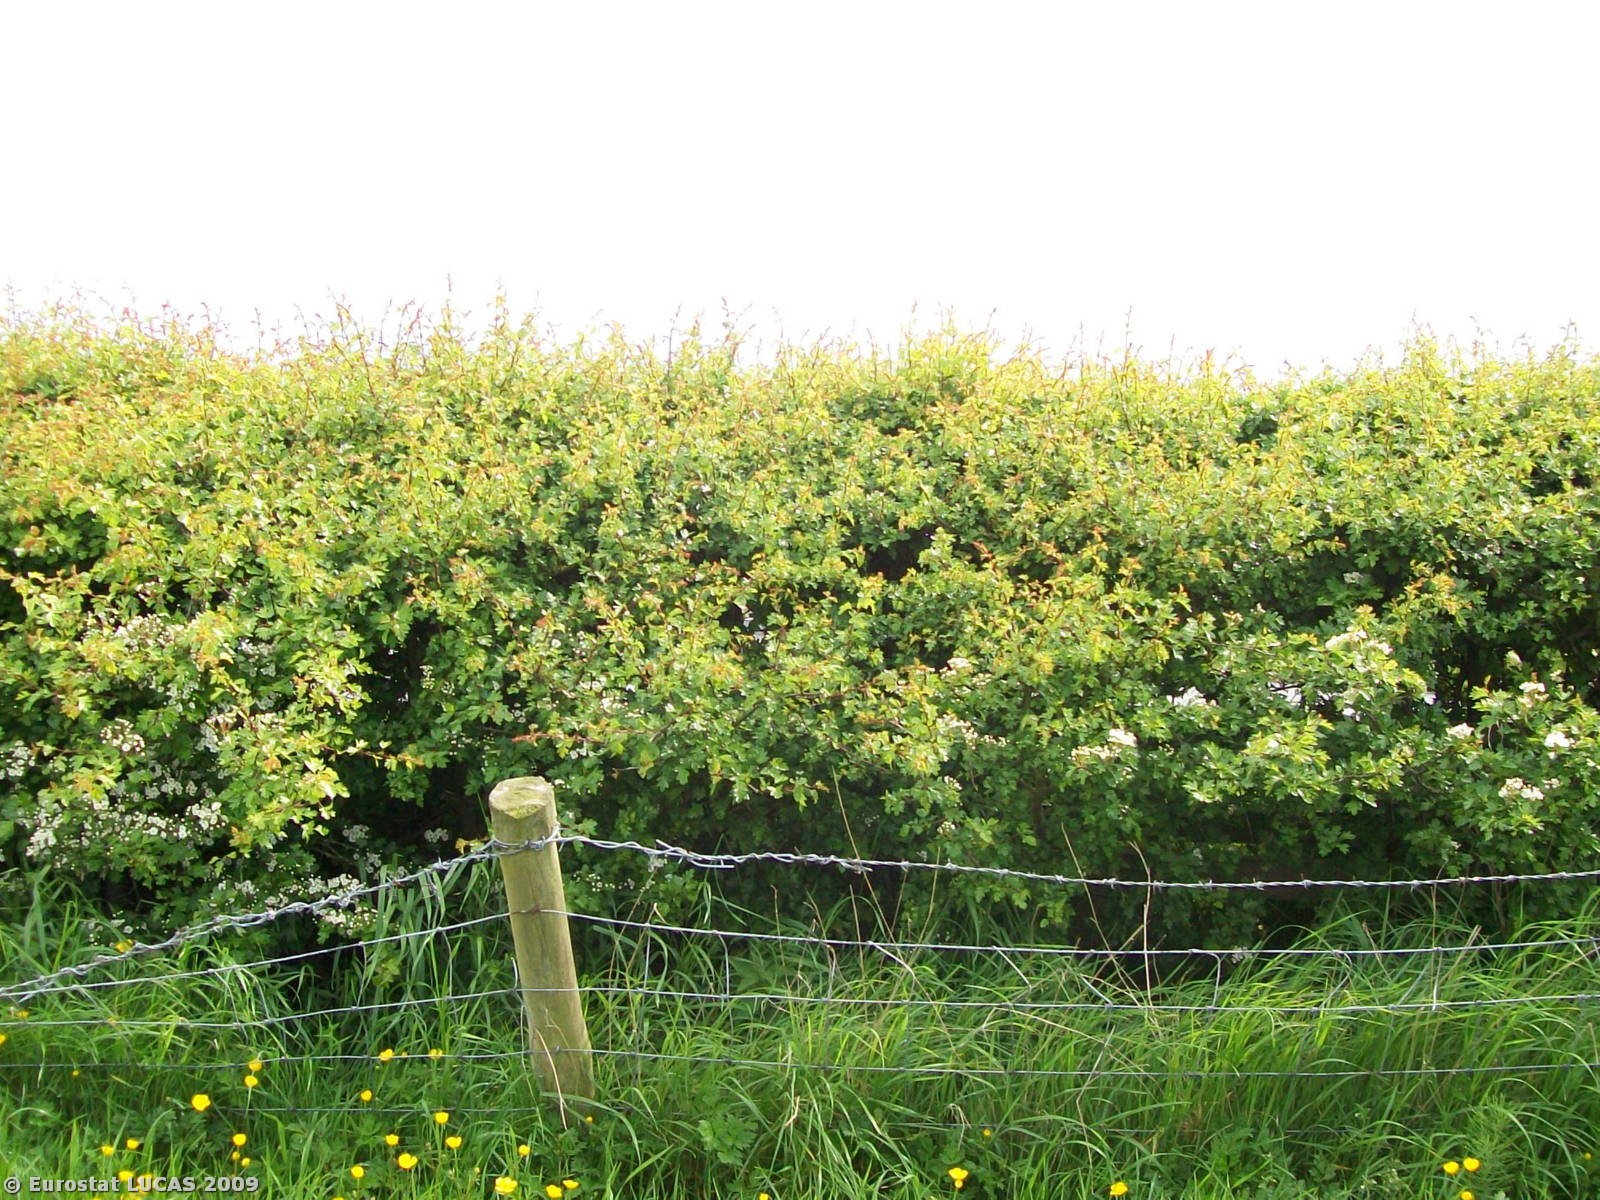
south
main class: Grassland
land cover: Grassland without tree/shrub cover
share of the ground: 25 - 50 %
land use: Agriculture (excluding fallow land and kitchen gardens)
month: May
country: GB
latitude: 53.9247
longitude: -2.9403
